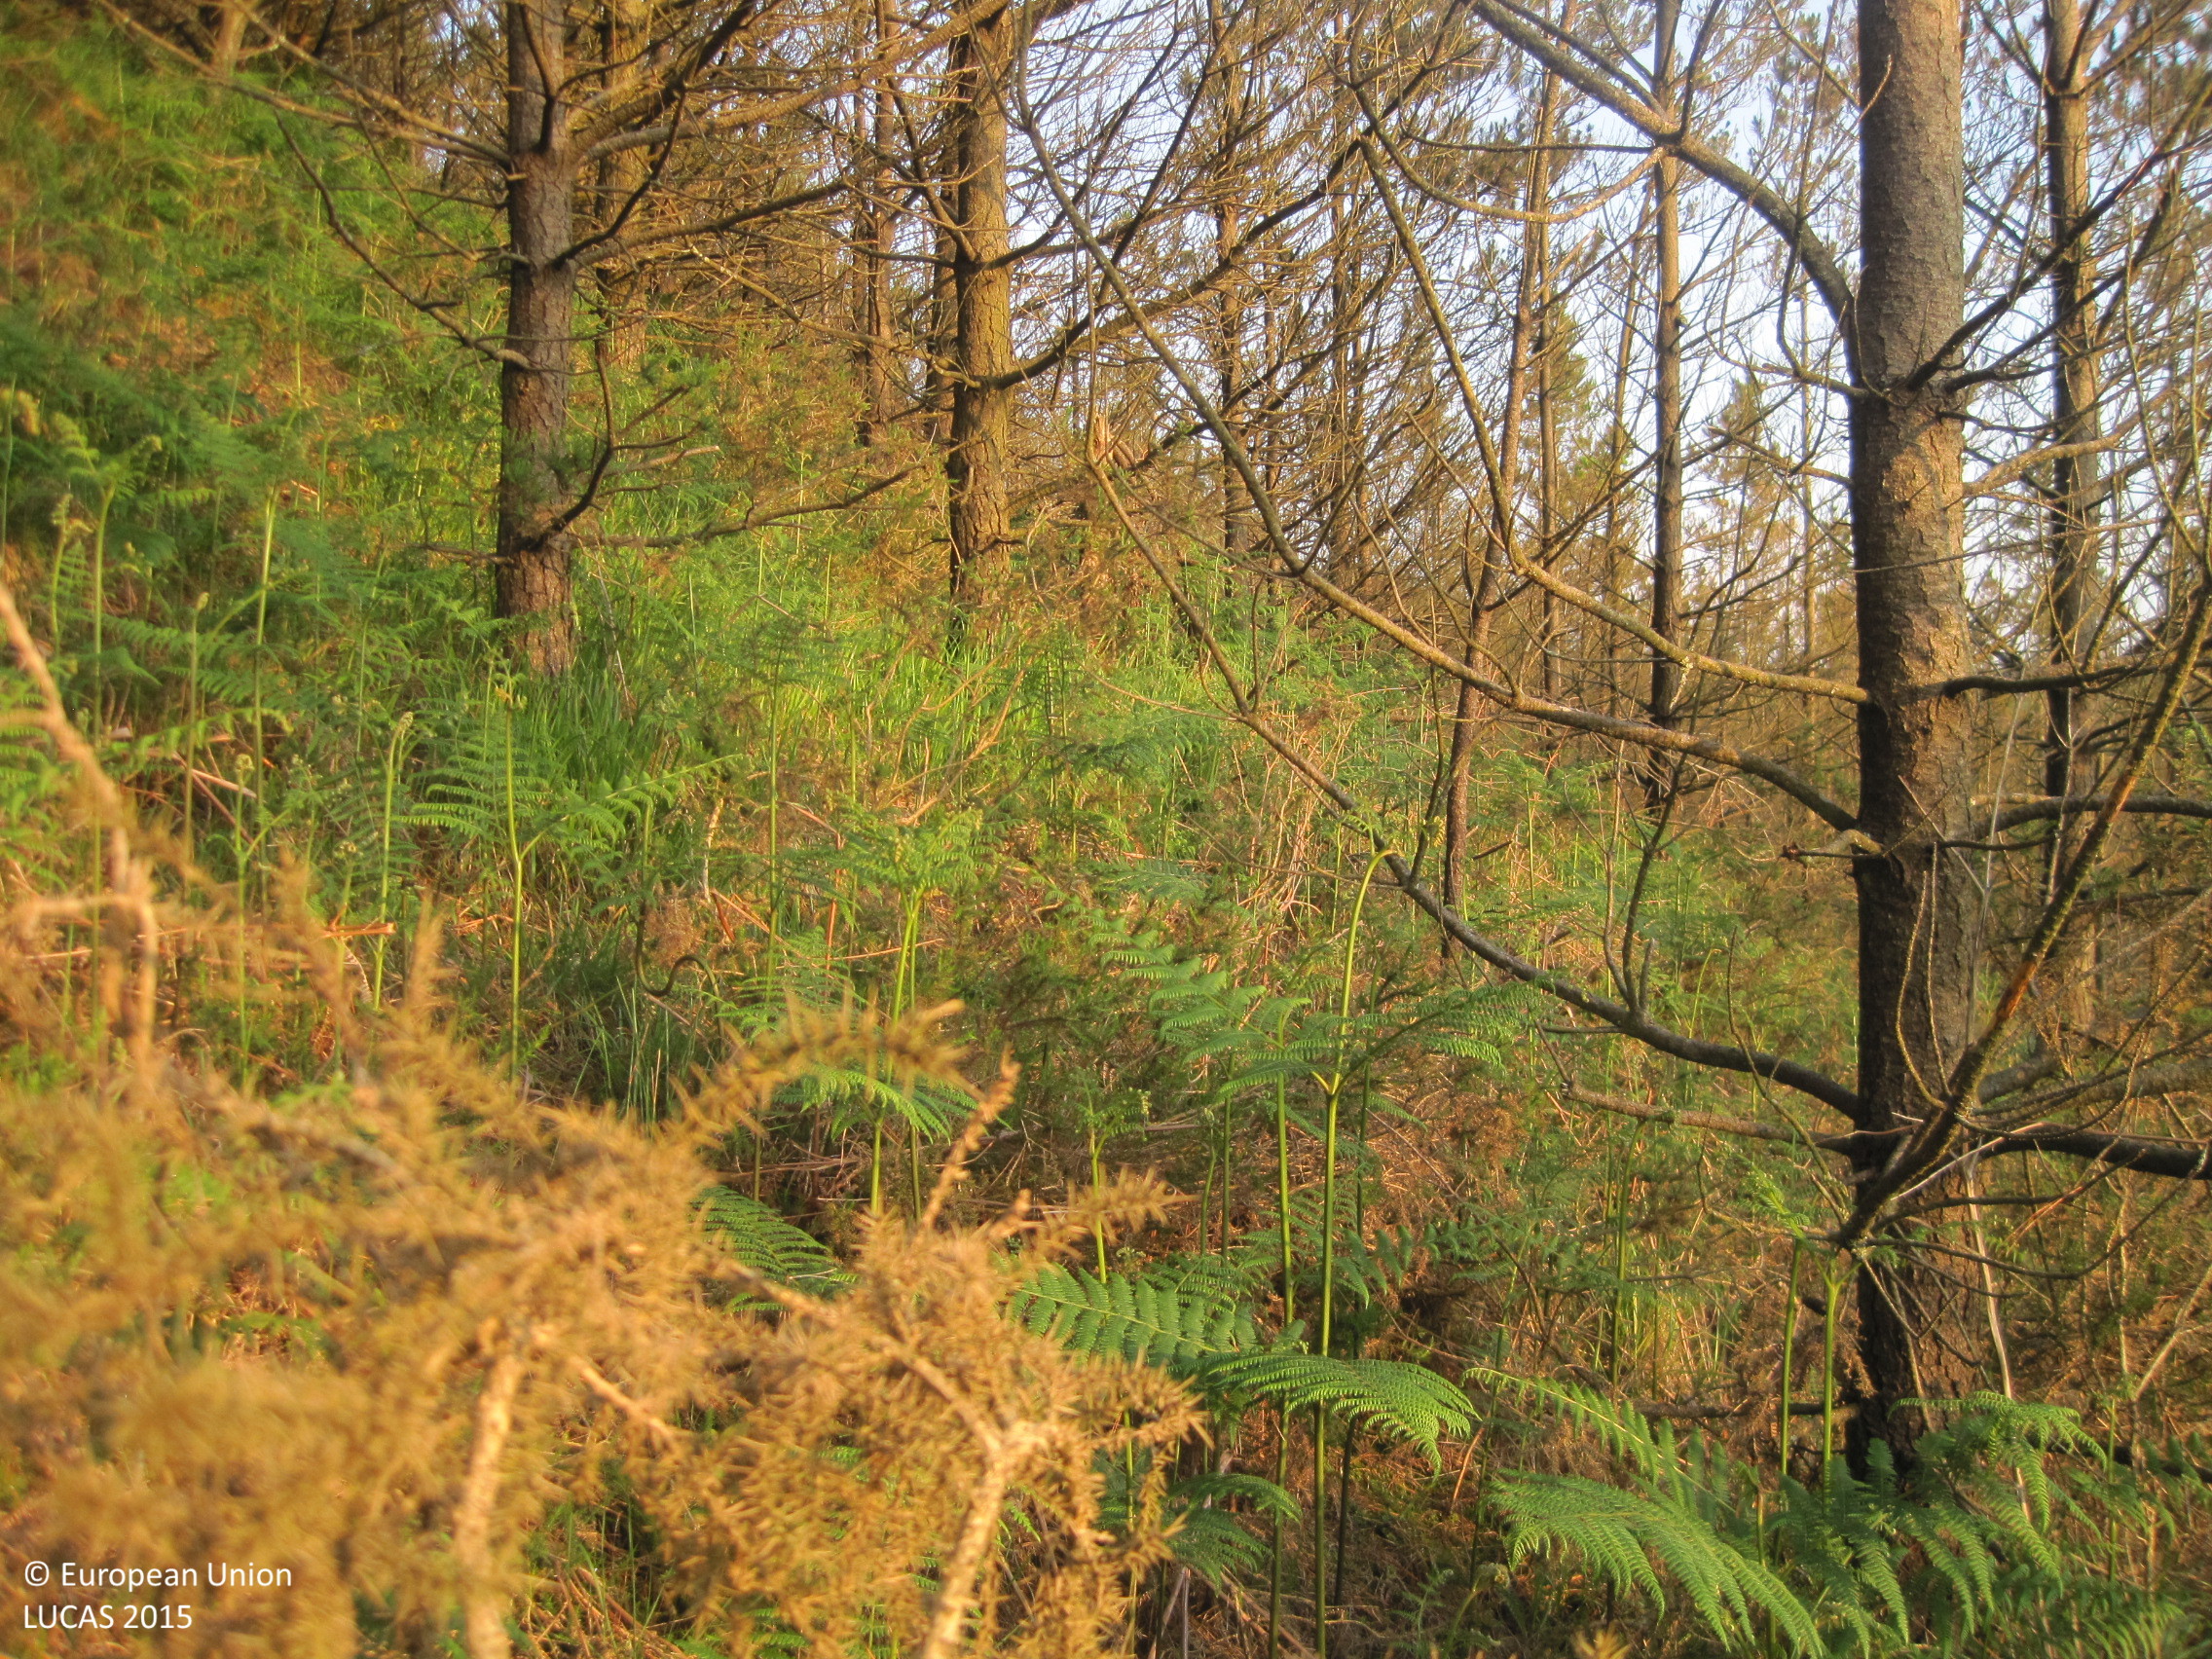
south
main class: Woodland
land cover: Pine dominated coniferous woodland
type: hemiboreal forest and nemoral coniferous forest and mixed broadleaved-coniferous forest
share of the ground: > 75 %
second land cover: Grassland without tree/shrub cover
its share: > 75 %
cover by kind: coniferous forest trees 90 %, shrubs 5 %, herbaceous plants 5 %
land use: Forestry
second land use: Agriculture (excluding fallow land and kitchen gardens)
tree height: > 5 m
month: June
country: ES
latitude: 43.1602
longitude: -1.8387
